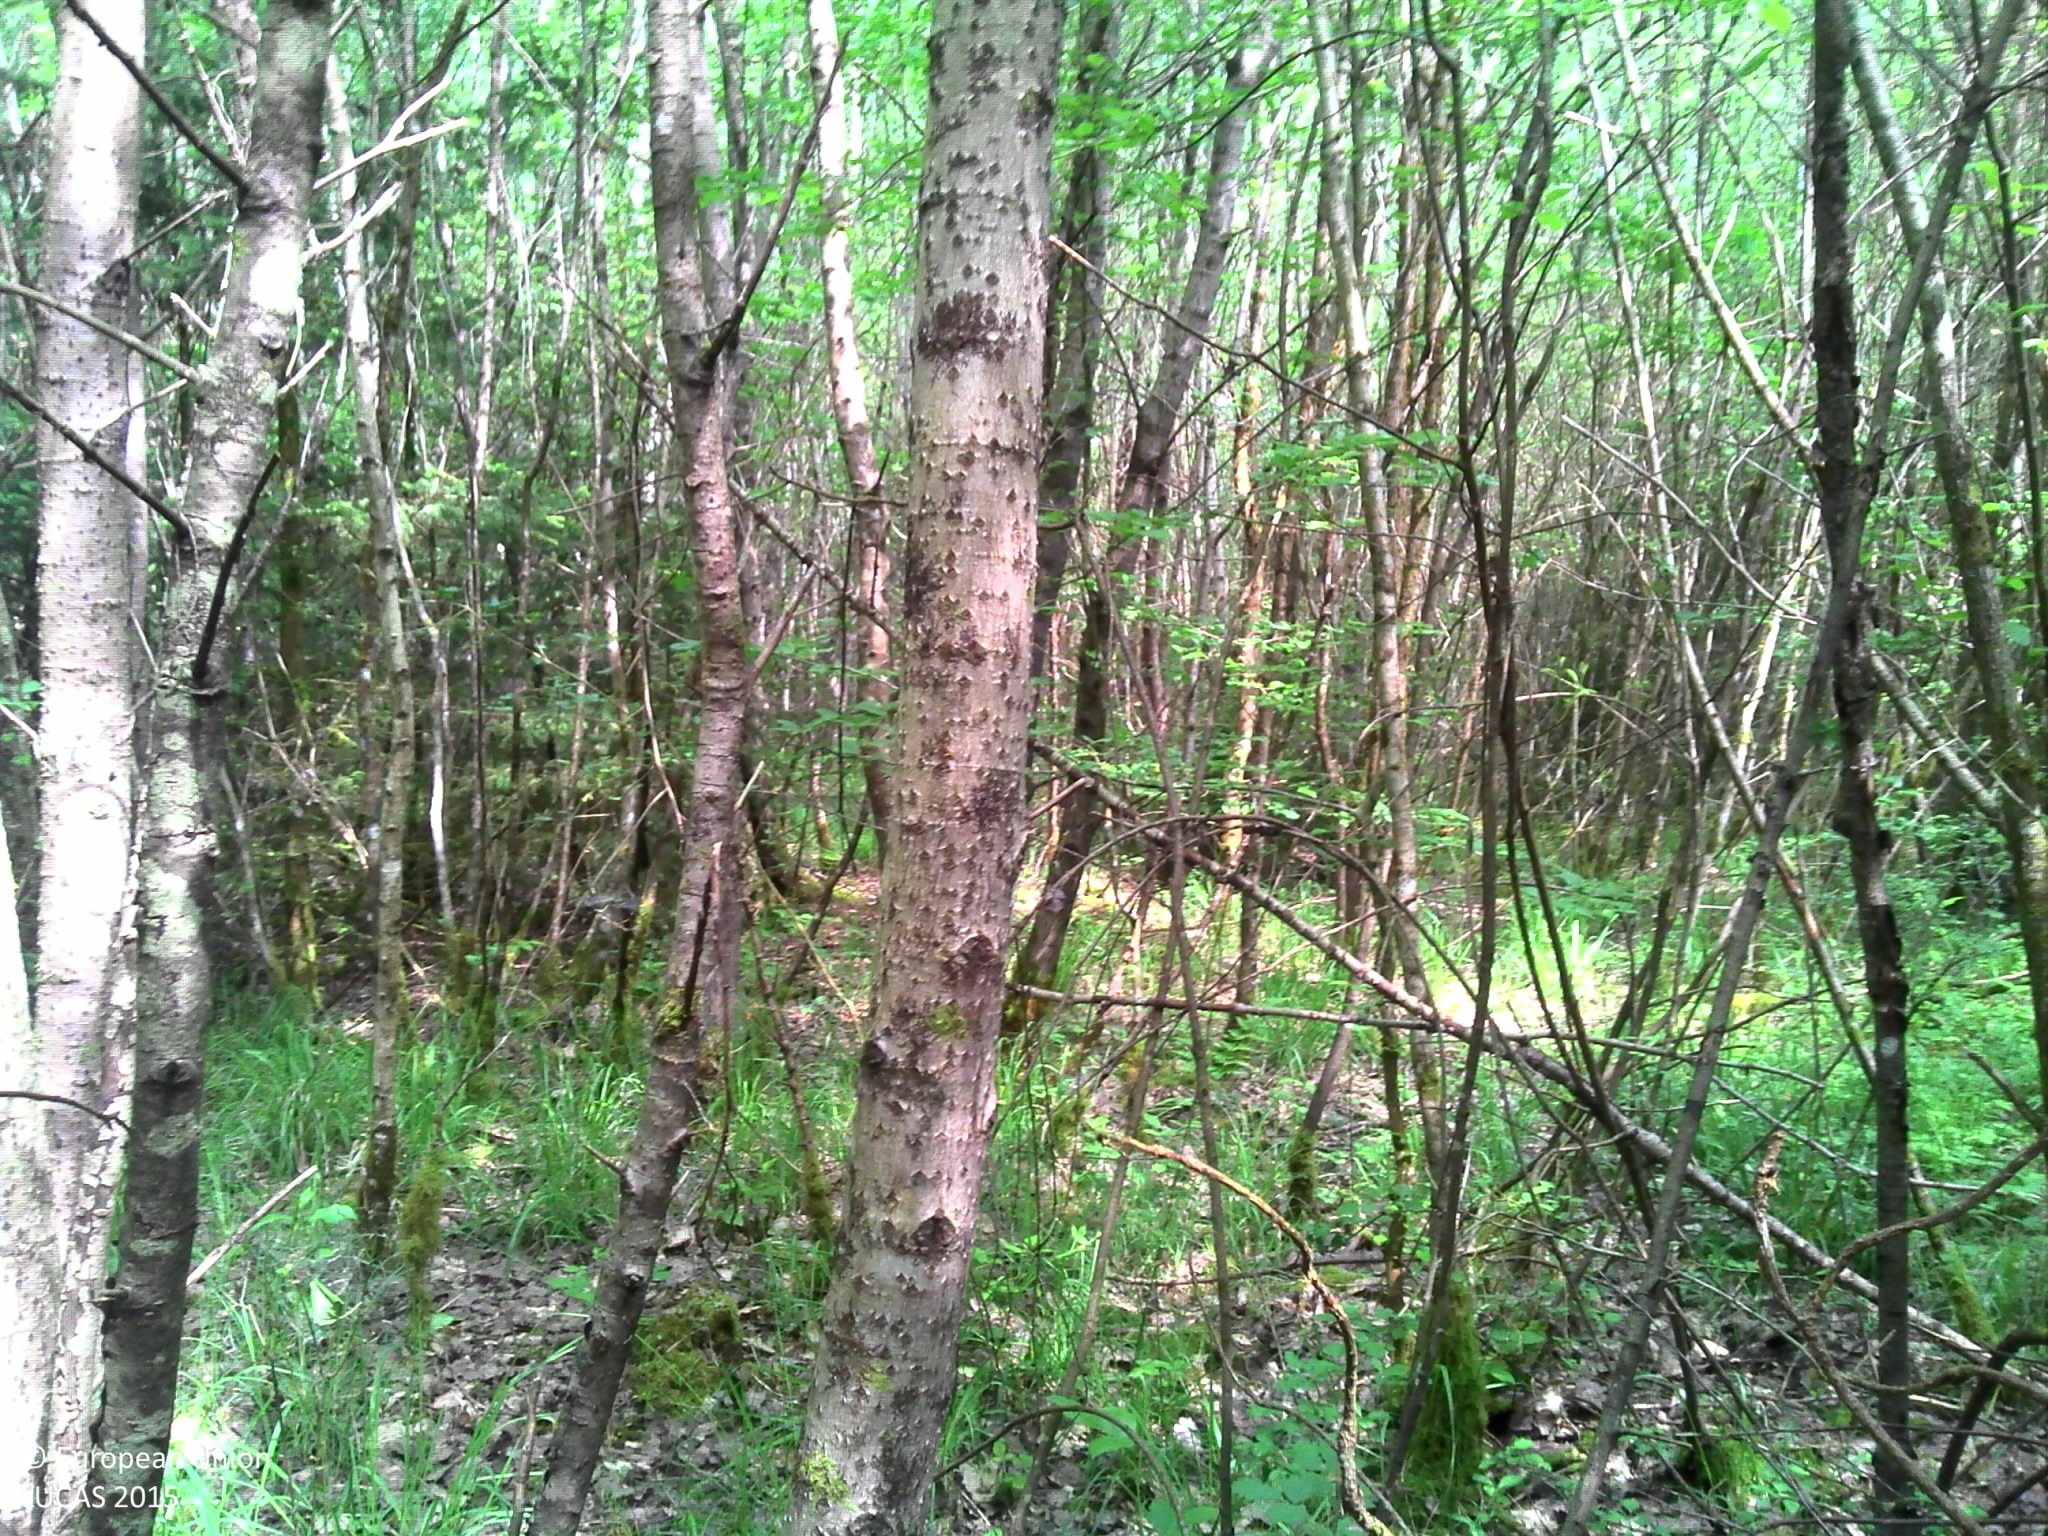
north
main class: Woodland
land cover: Spruce dominated mixed woodland
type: beech forest
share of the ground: > 75 %
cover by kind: coniferous forest trees 45 %, broadleaved forest trees 45 %, herbaceous plants 10 %
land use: Forestry
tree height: > 5 m
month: May
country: FR
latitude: 47.9537
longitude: 6.0237
